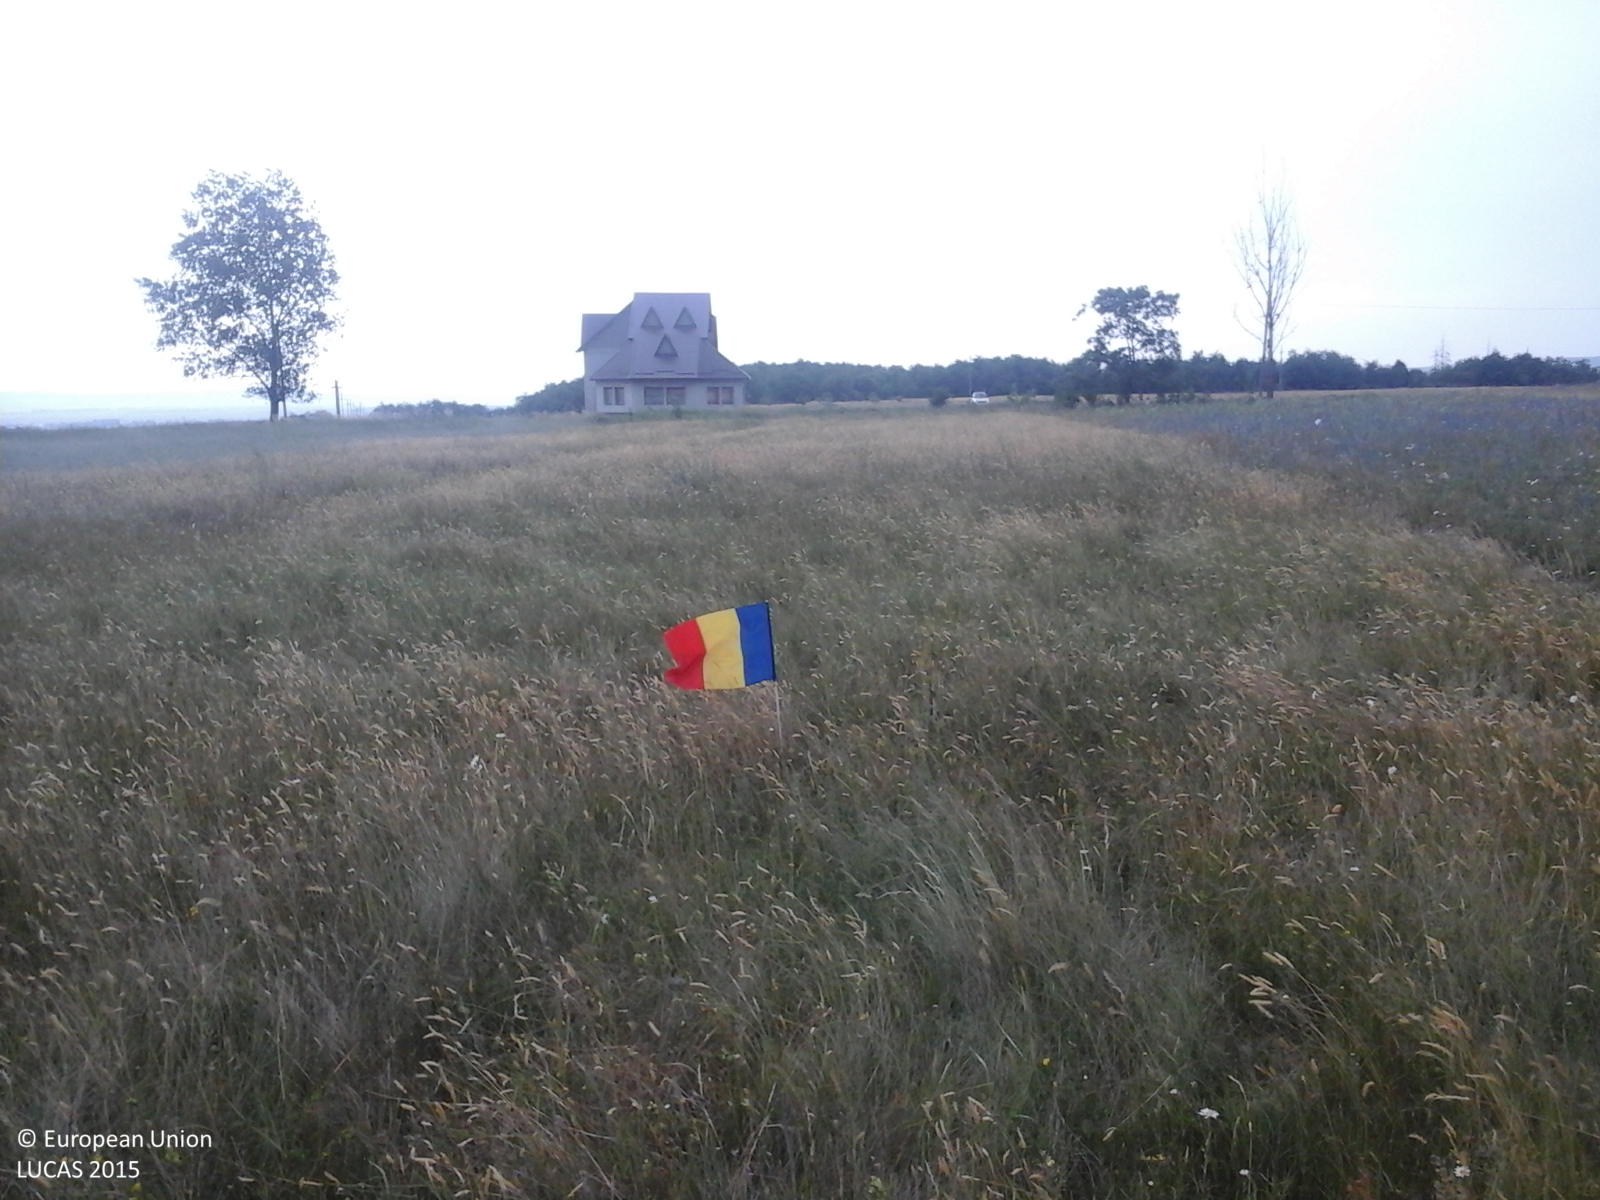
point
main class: Grassland
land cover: Grassland without tree/shrub cover
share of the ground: > 75 %
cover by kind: herbaceous plants 100 %
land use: Agriculture (excluding fallow land and kitchen gardens)
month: June
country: RO
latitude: 47.2627
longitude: 26.3793
